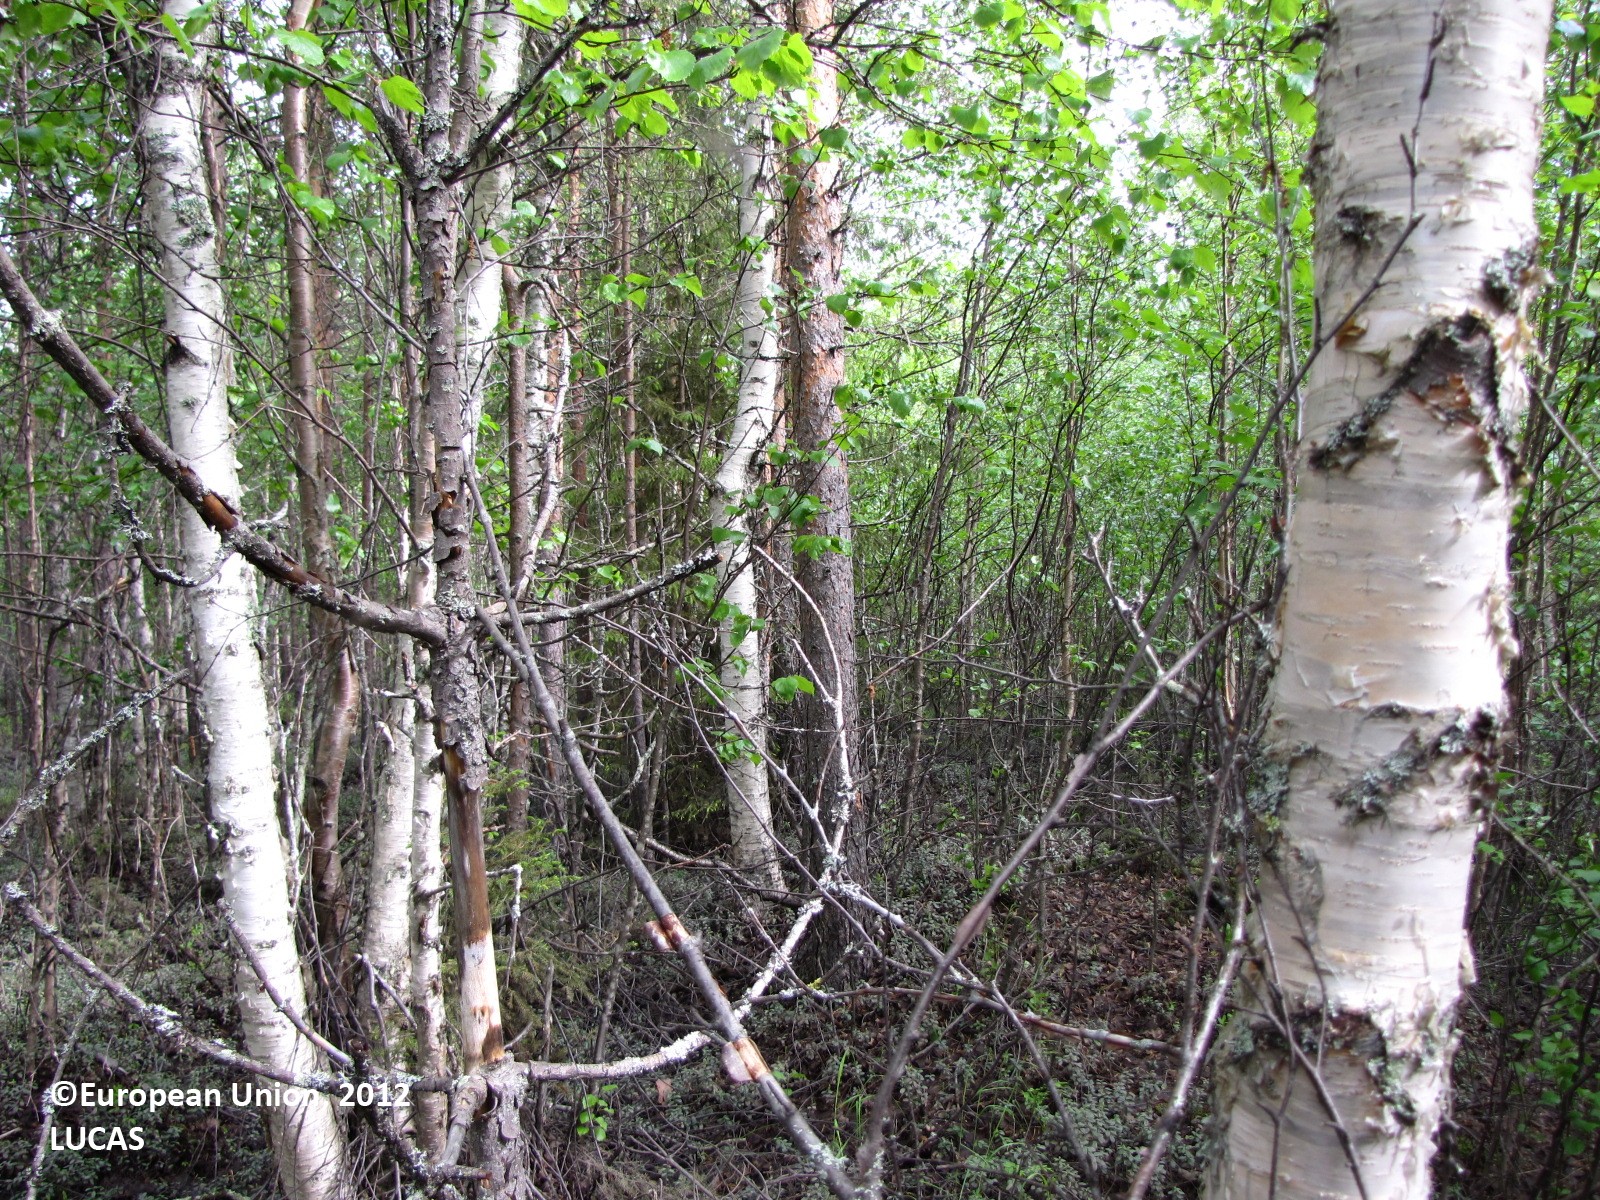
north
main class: Woodland
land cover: Pine dominated mixed woodland
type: boreal forest
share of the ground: 50 - 75 %
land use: Forestry
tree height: > 5 m
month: June
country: FI
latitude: 66.4723
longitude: 24.3423
